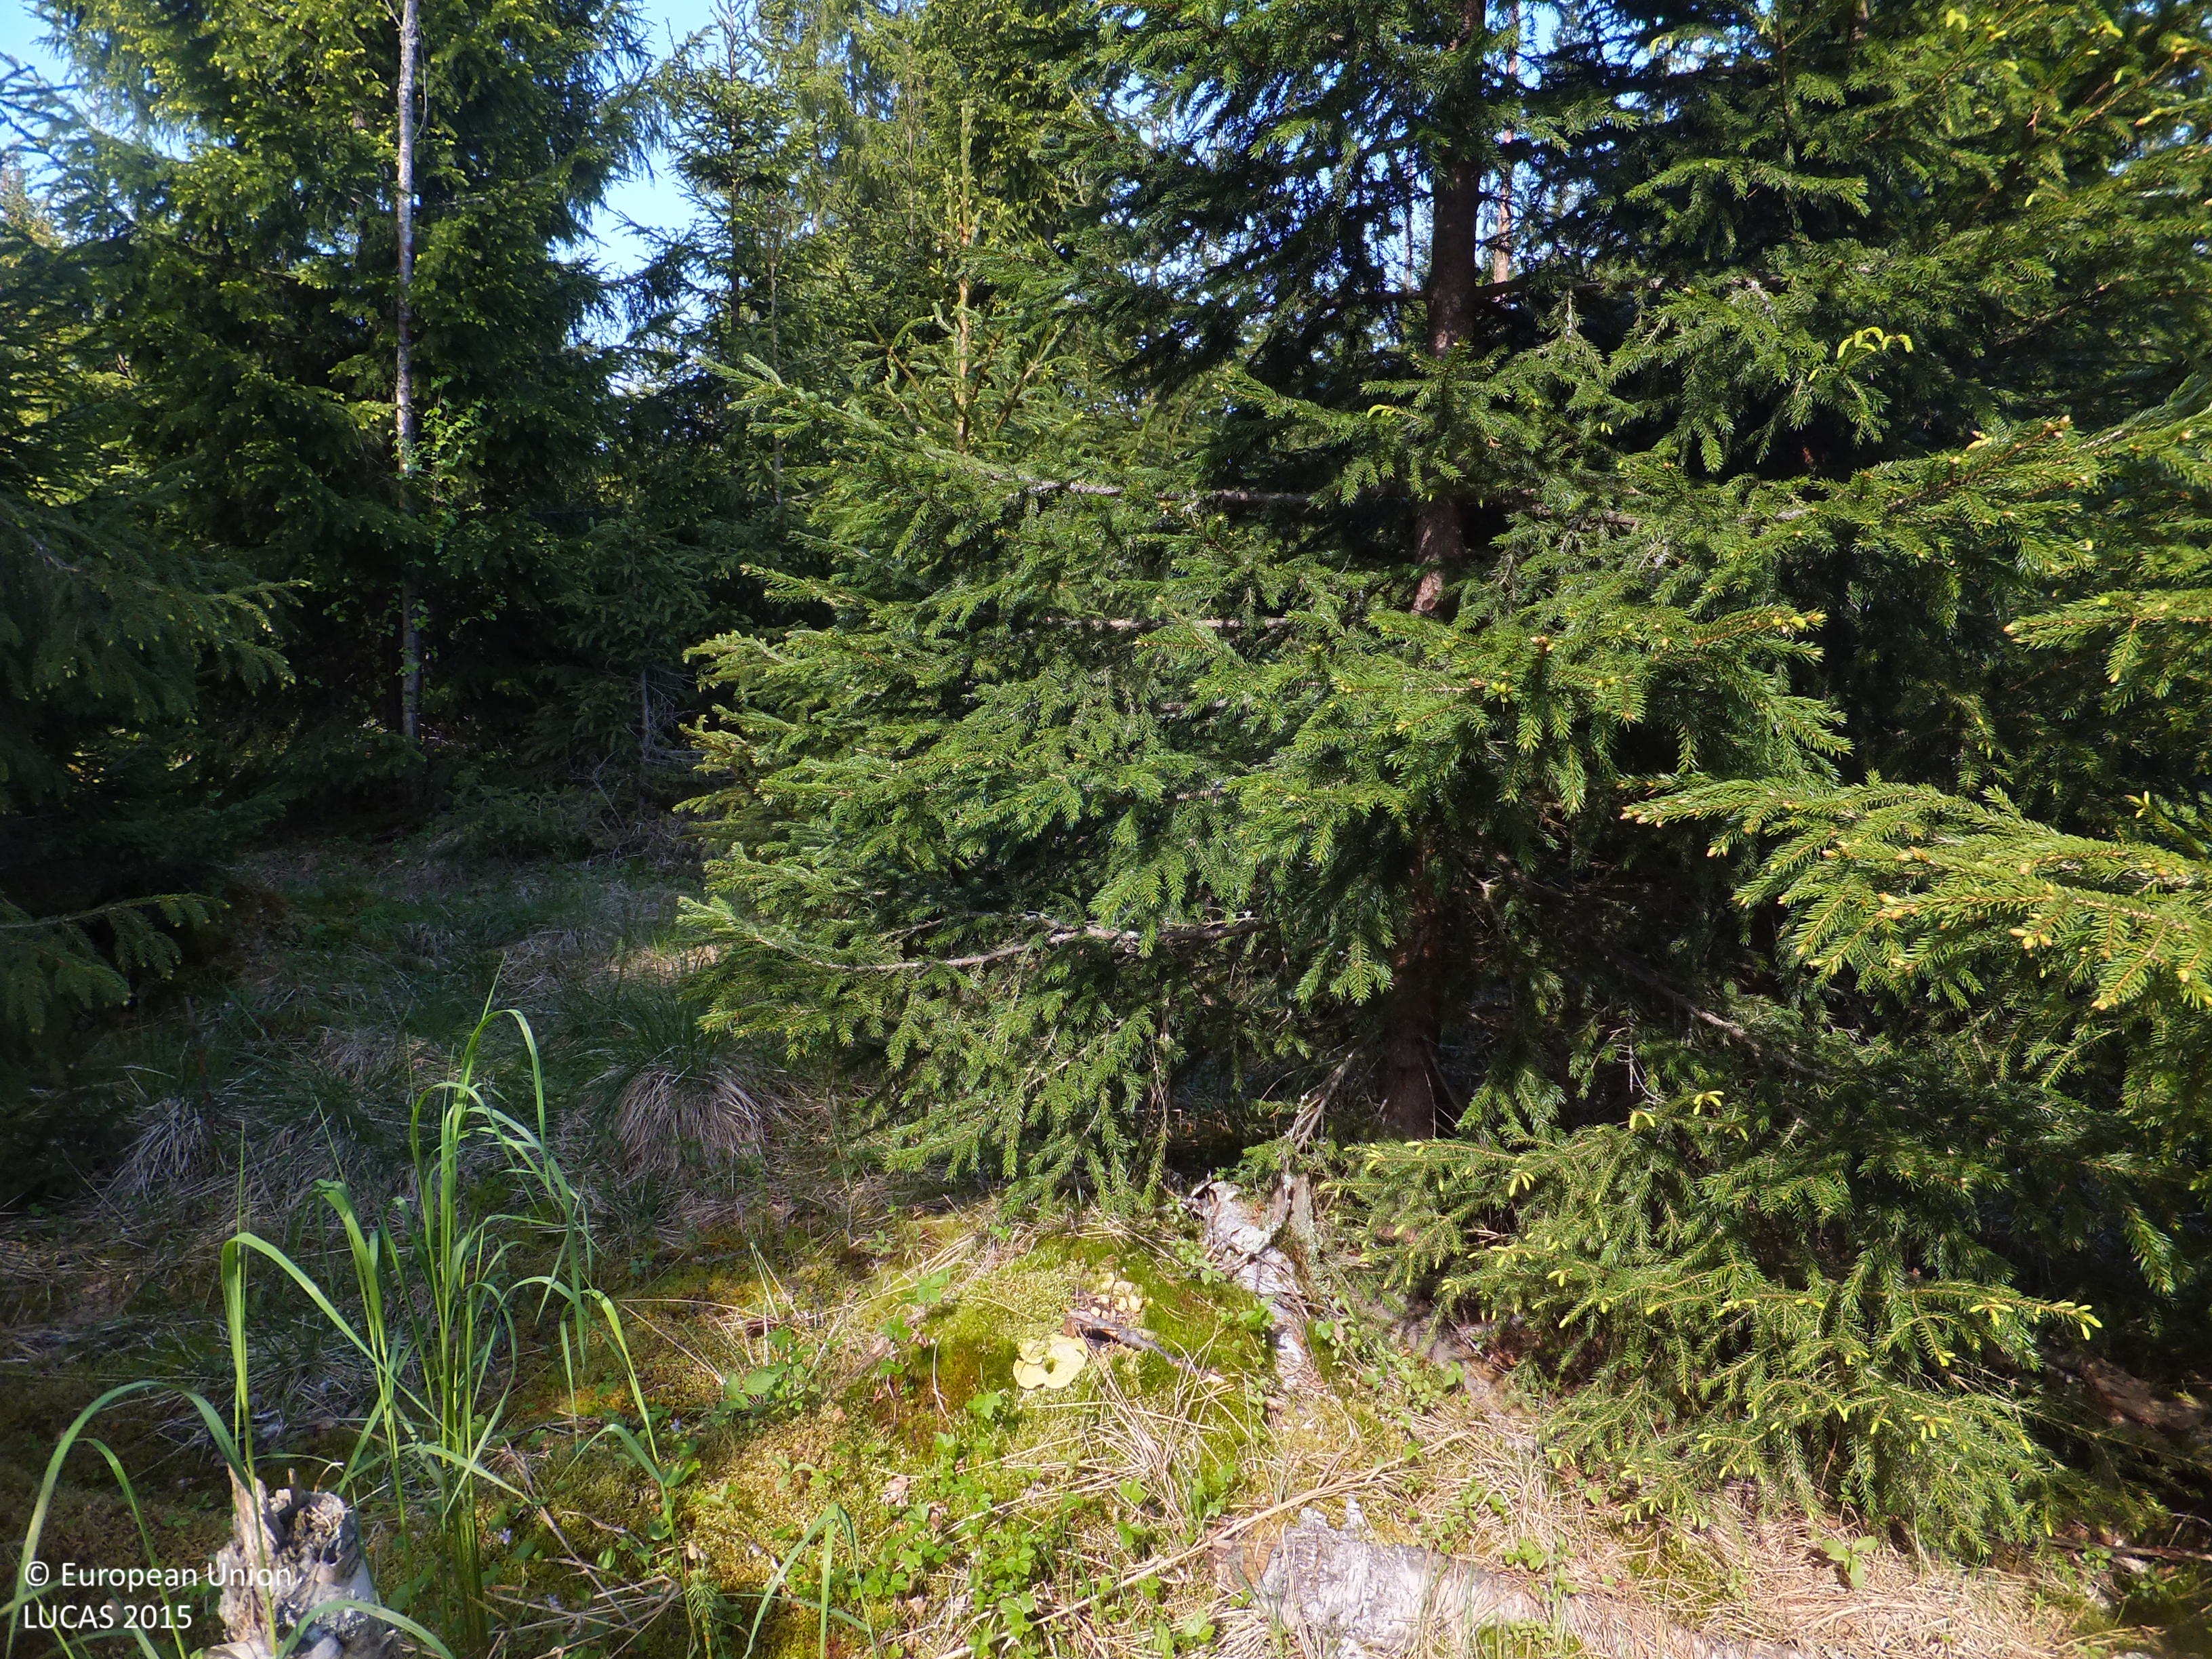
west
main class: Woodland
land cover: Spruce dominated coniferous woodland
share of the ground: 50 - 75 %
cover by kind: coniferous forest trees 60 %, herbaceous plants 30 %, lichens and mosses 10 %
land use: Forestry
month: June
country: FI
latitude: 63.5483
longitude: 22.7878
